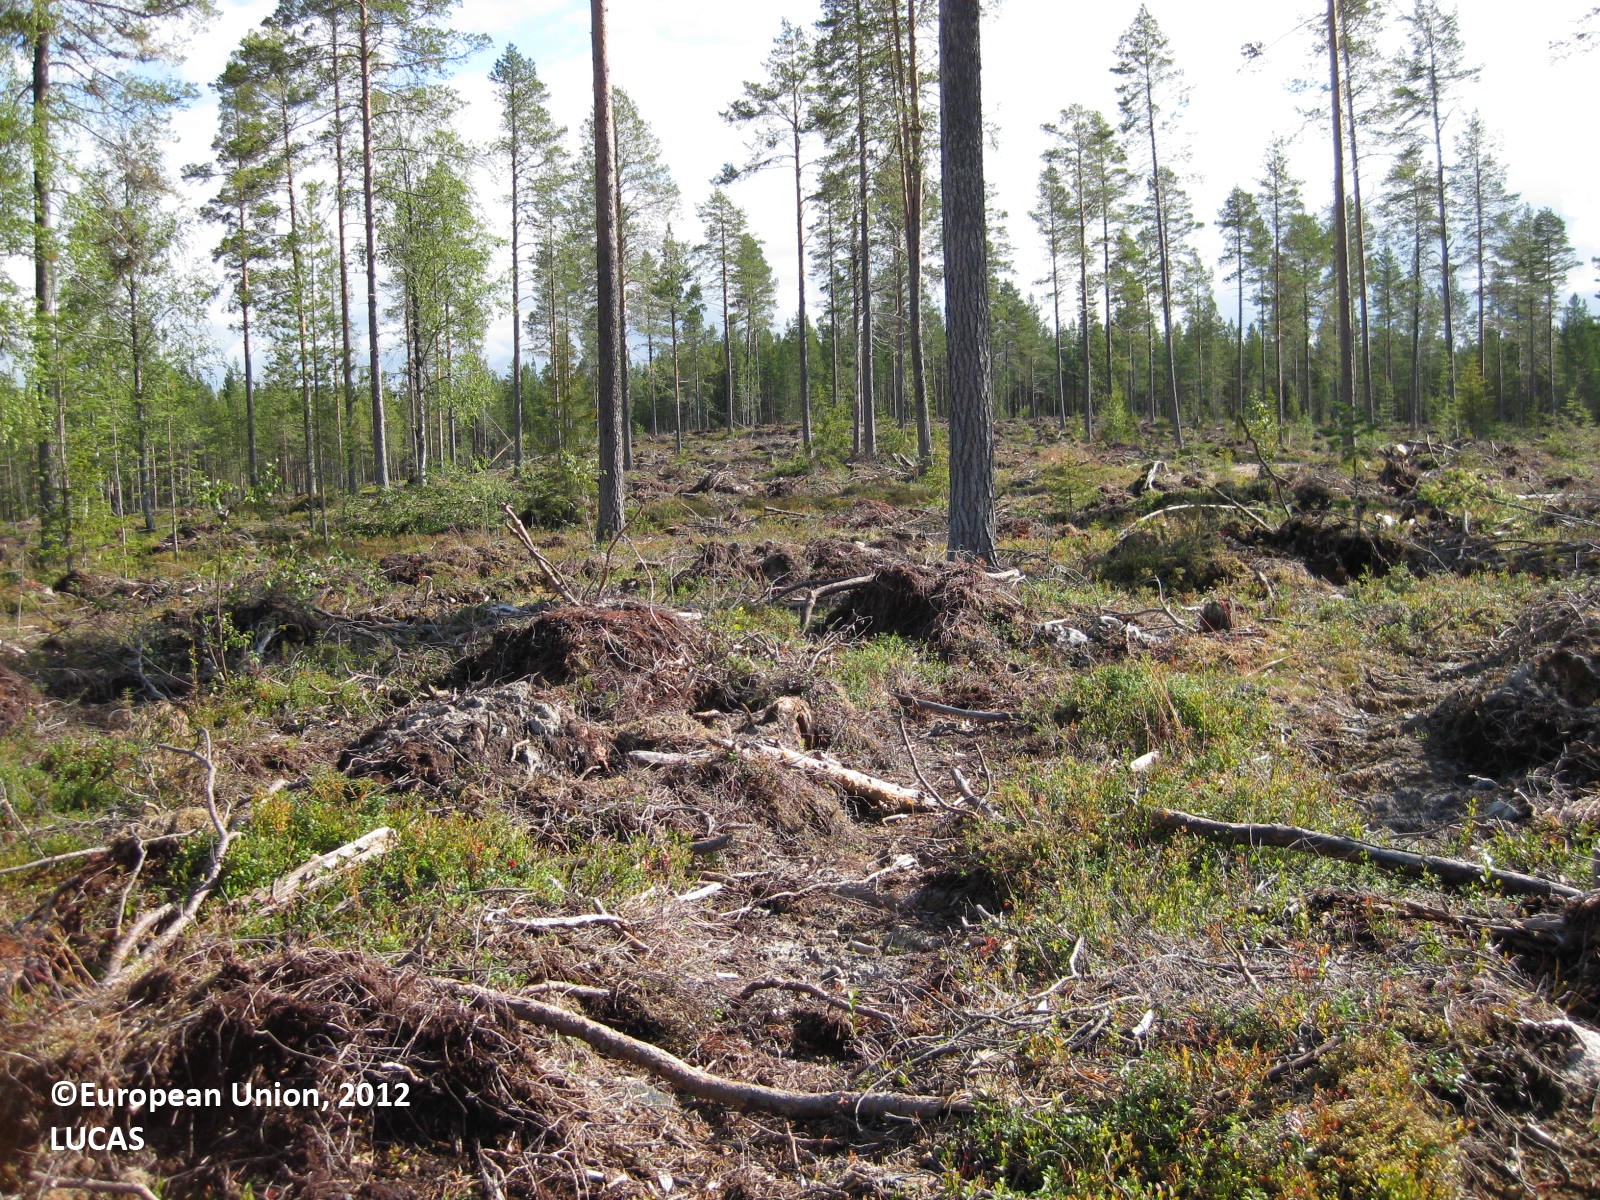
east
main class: Woodland
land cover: Pine dominated coniferous woodland
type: boreal forest
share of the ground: 10 - 25 %
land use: Forestry
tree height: > 5 m
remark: Clear cut
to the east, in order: Pine dominated coniferous woodland; Tracks; Pine dominated mixed woodland; Shrubland with sparse tree cover; Ditches and canals; Pine dominated coniferous woodland; Ditches and canals; Pine dominated coniferous woodland
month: August
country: FI
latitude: 66.1532
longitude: 28.8498
